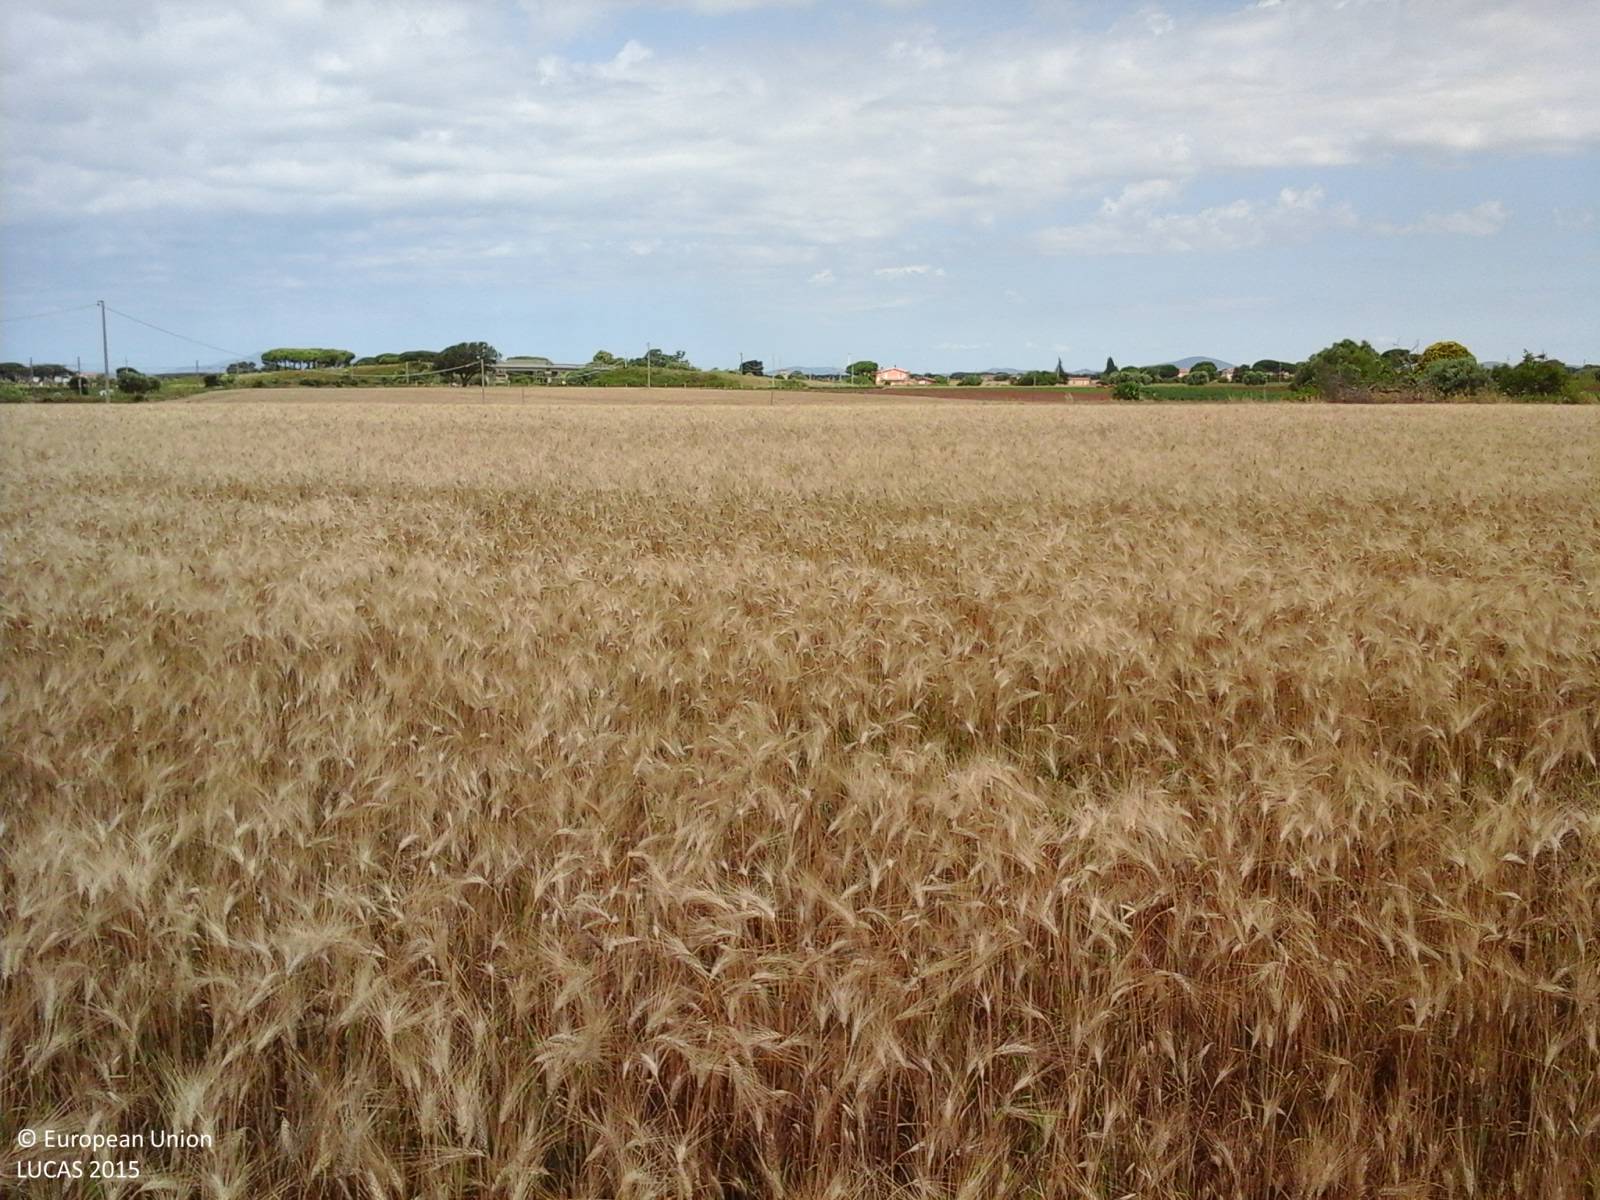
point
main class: Cropland
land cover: Durum wheat
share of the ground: > 75 %
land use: Agriculture (excluding fallow land and kitchen gardens)
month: June
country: IT
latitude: 42.2972
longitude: 11.6558
